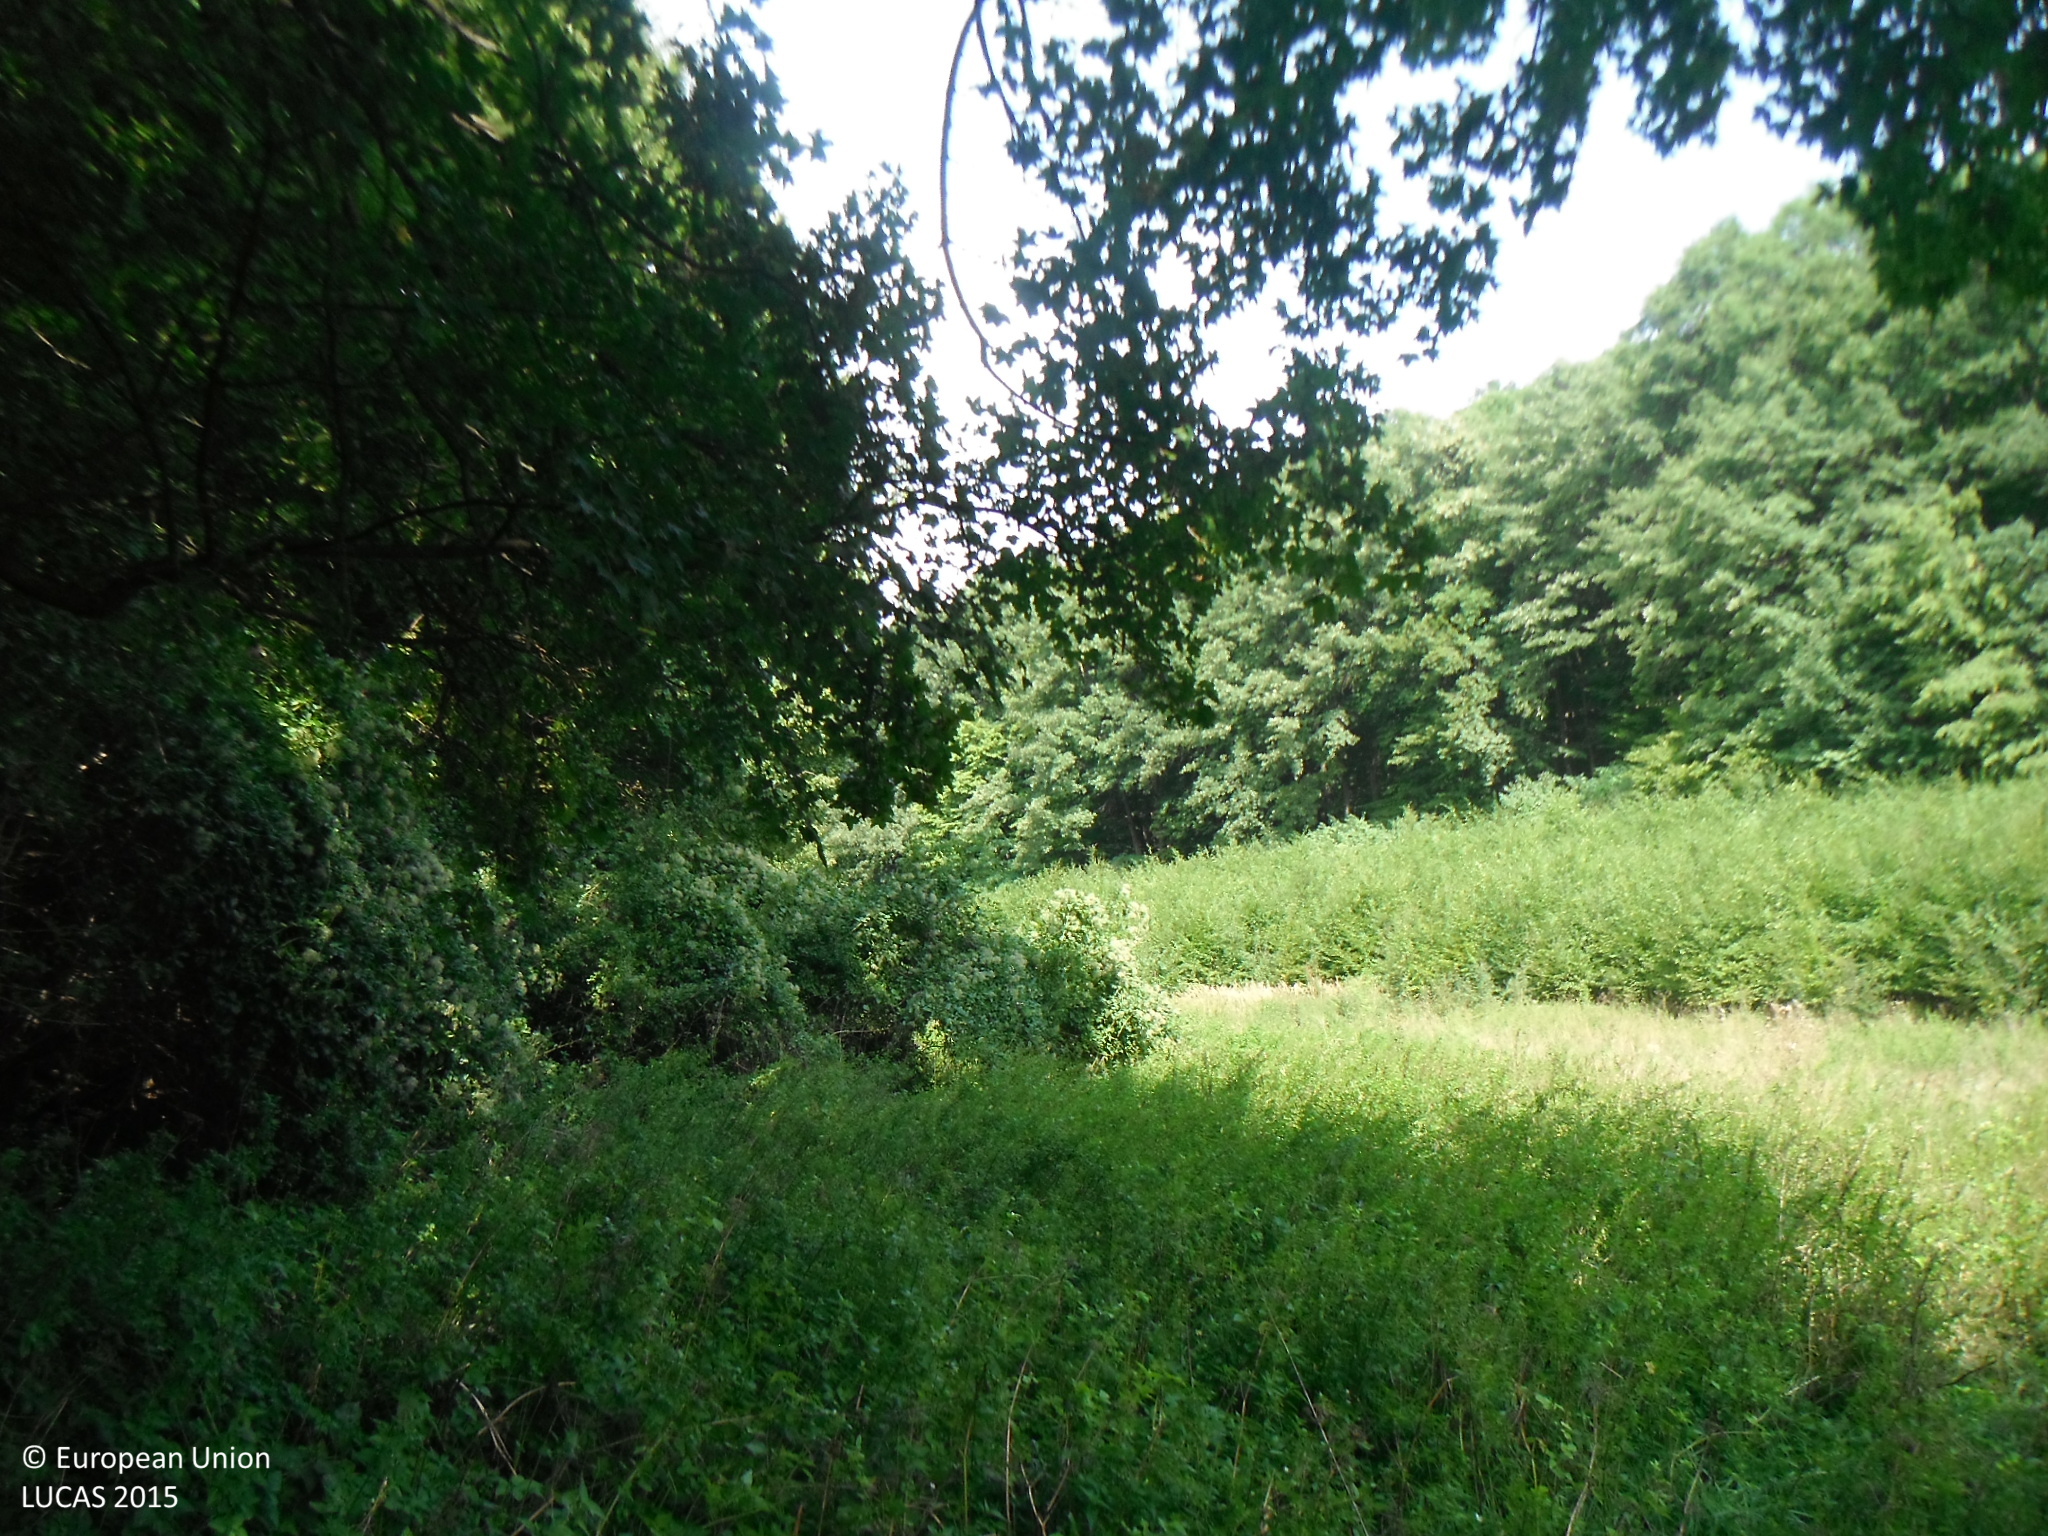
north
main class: Woodland
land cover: Broadleaved woodland
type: mesophytic deciduous forest
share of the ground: > 75 %
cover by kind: broadleaved forest trees 100 %
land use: Forestry
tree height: > 5 m
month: September
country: SK
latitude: 48.7464
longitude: 17.4772
